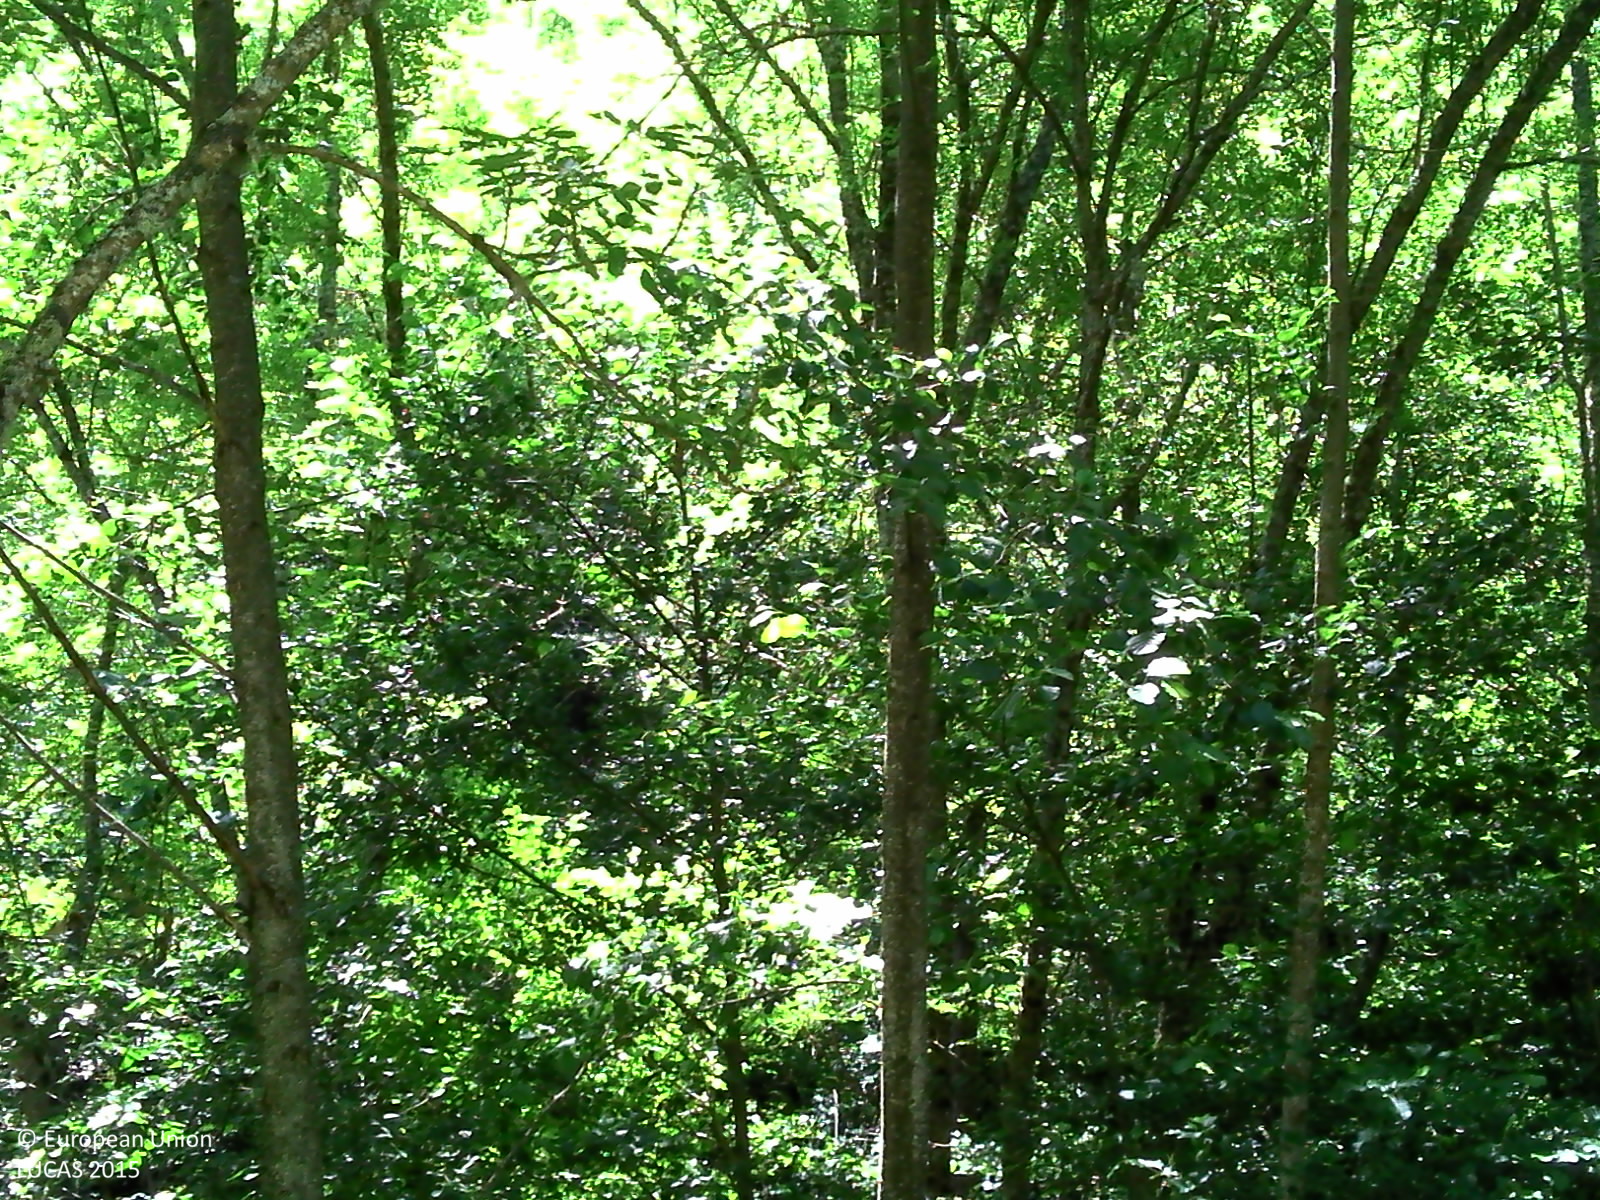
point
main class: Woodland
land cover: Broadleaved woodland
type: mesophytic deciduous forest
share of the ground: > 75 %
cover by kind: broadleaved forest trees 90 %, herbaceous plants 10 %
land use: Semi-natural and natural areas not in use
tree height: > 5 m
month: July
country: FR
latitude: 42.7266
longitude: 2.1083
